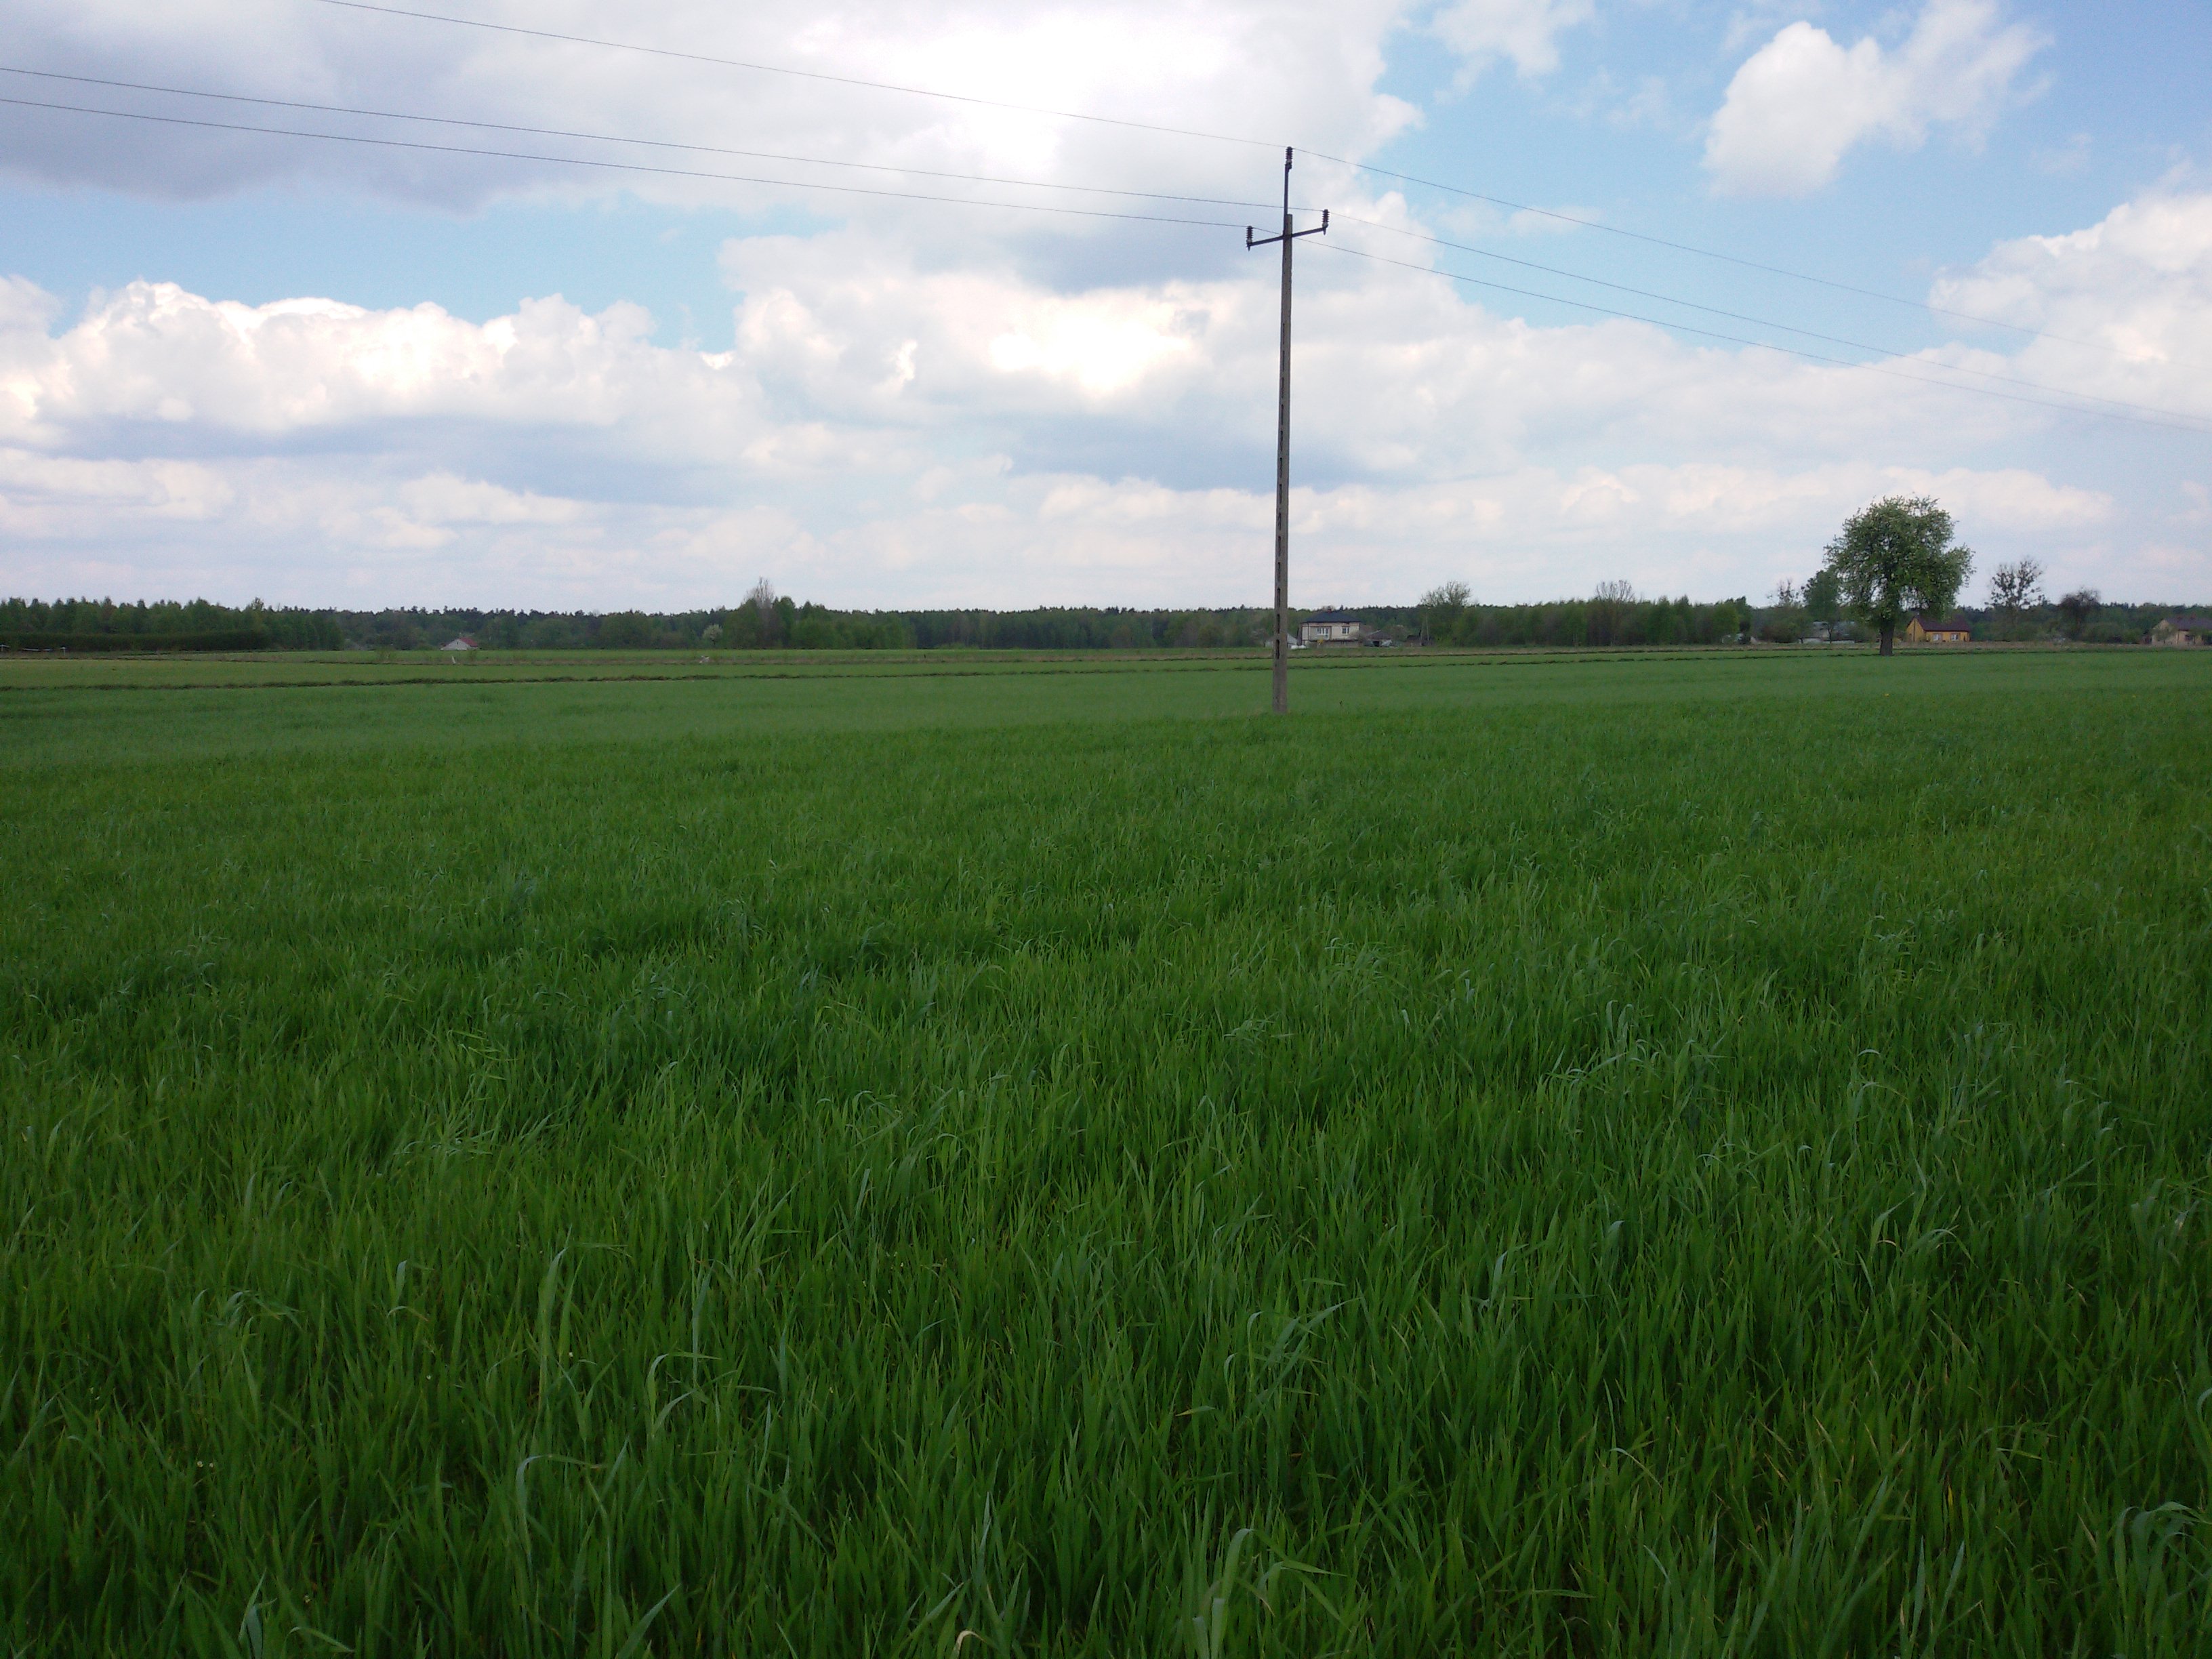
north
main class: Cropland
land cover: Triticale
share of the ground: > 75 %
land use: Agriculture (excluding fallow land and kitchen gardens)
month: May
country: PL
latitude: 51.4072
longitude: 21.5966
